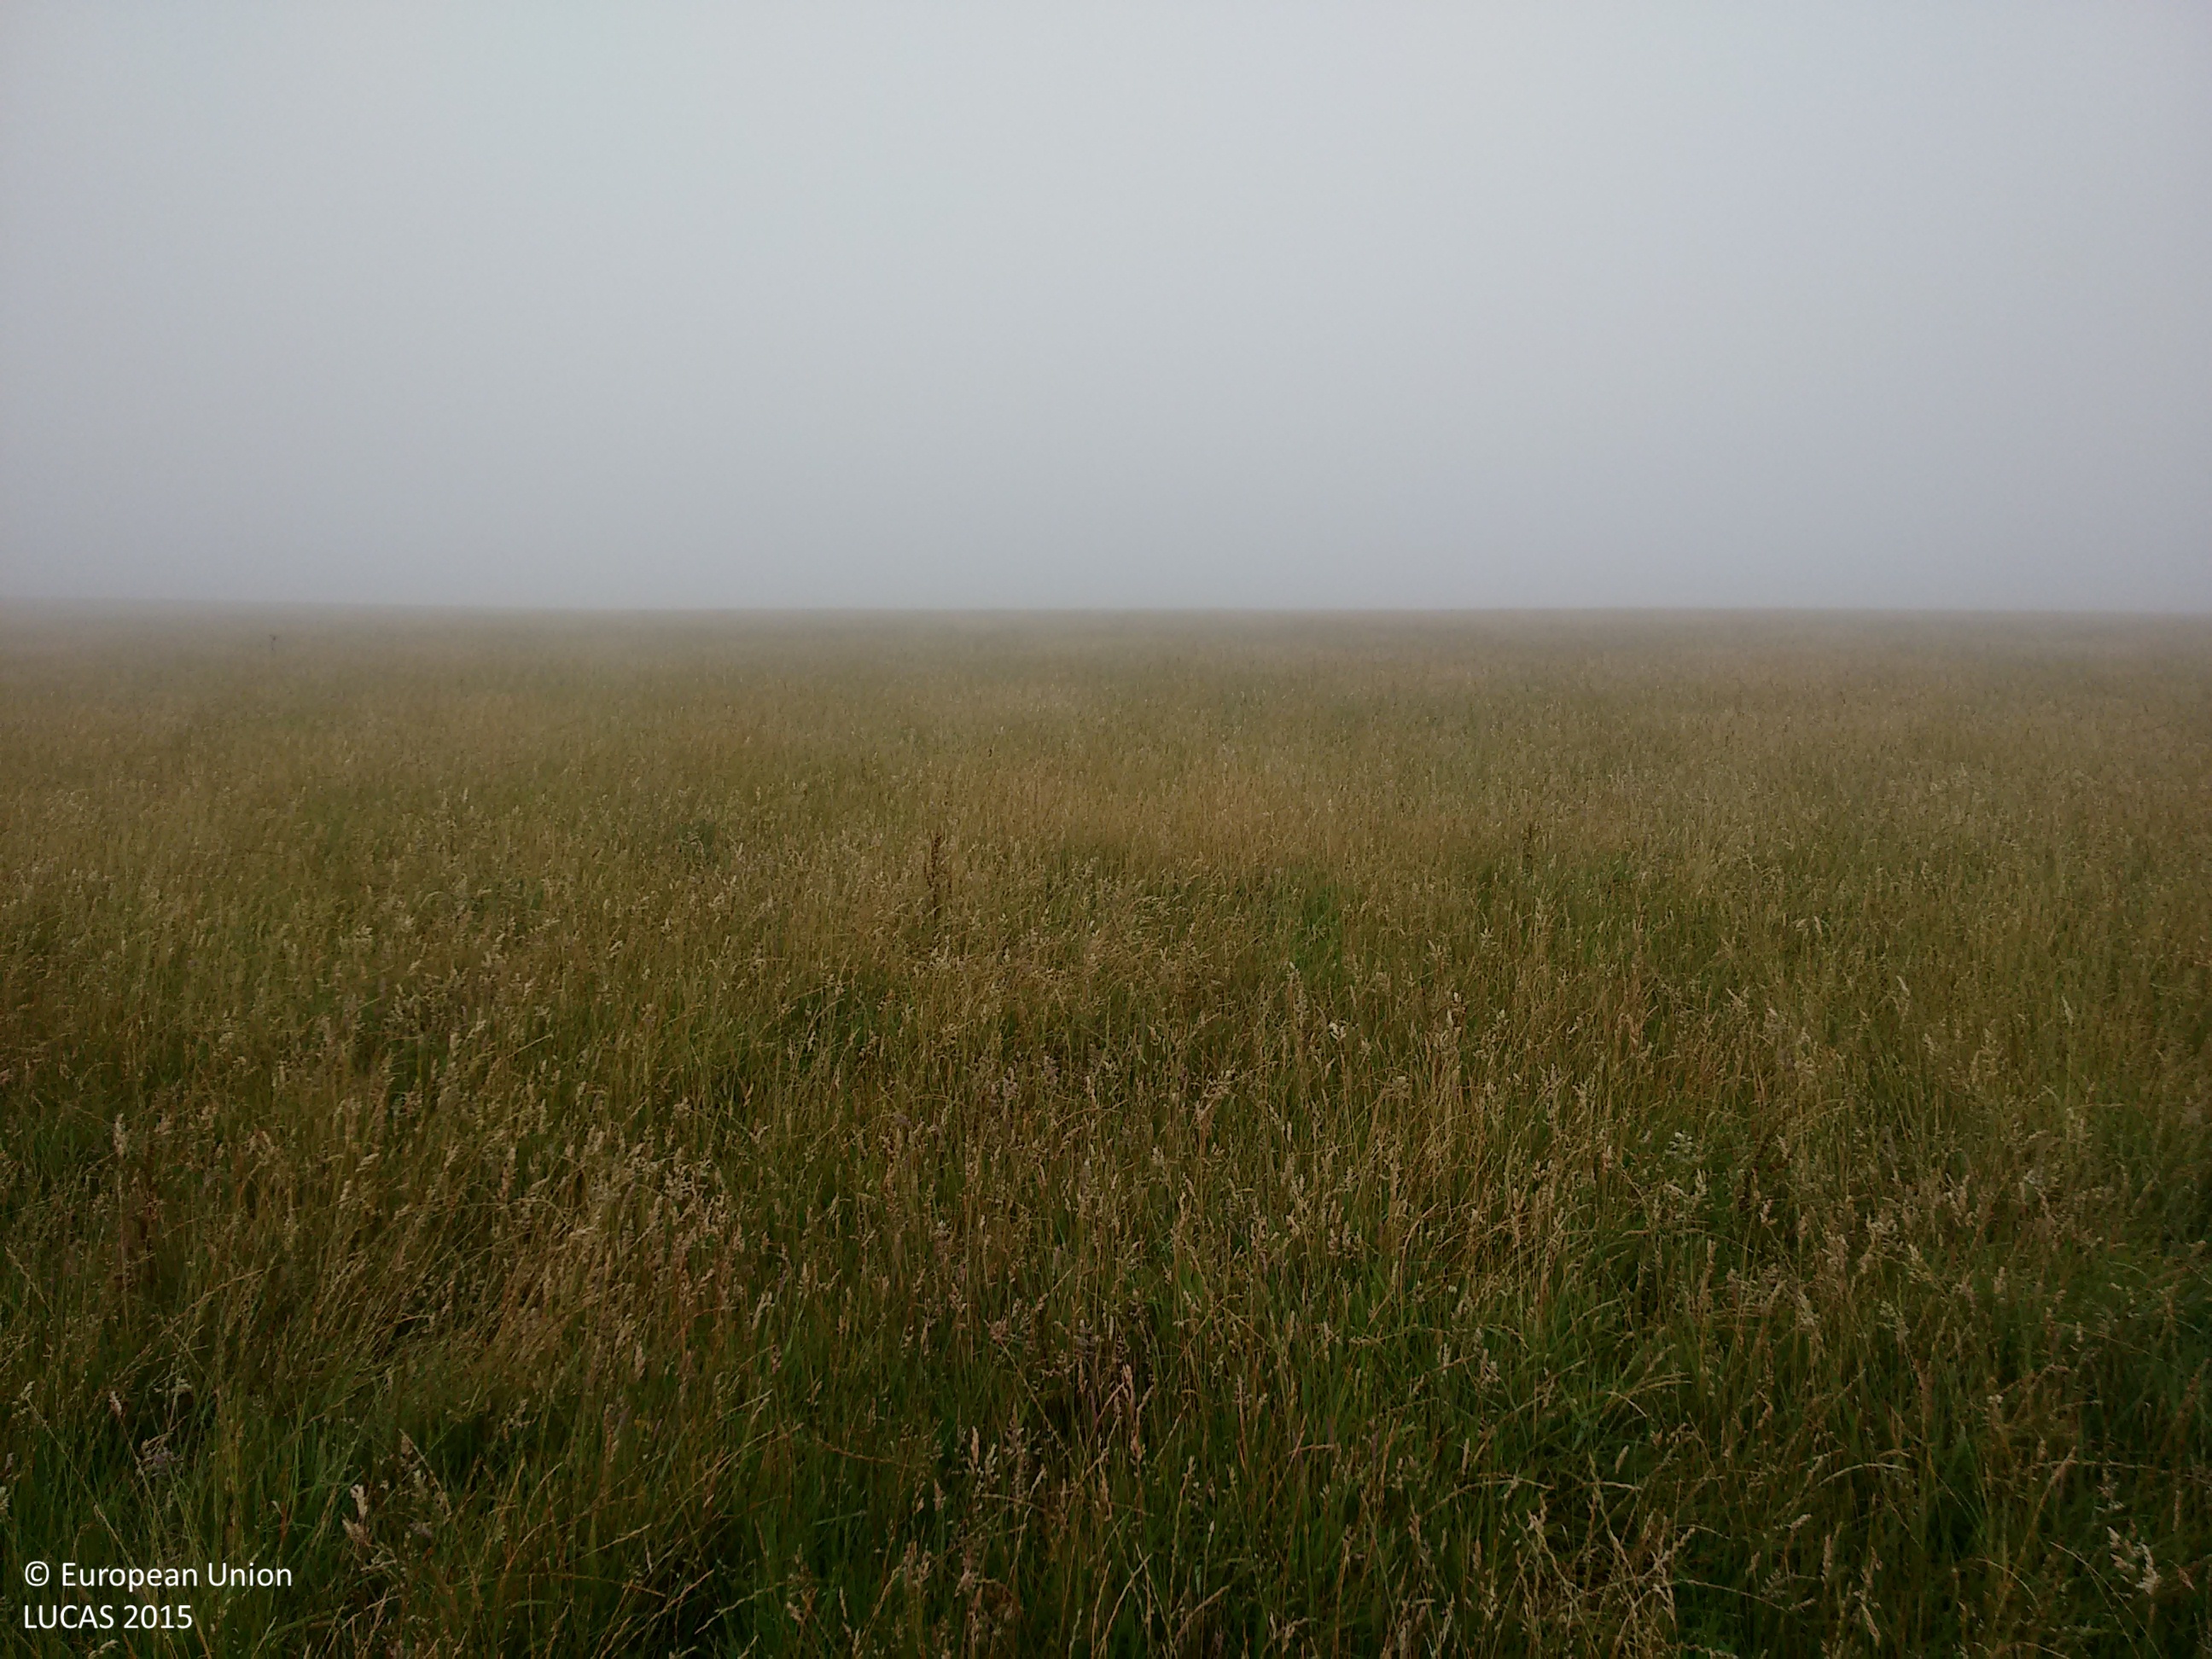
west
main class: Grassland
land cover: Grassland without tree/shrub cover
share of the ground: > 75 %
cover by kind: herbaceous plants 100 %
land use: Agriculture (excluding fallow land and kitchen gardens)
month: August
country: GB
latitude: 51.1467
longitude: -3.7991
